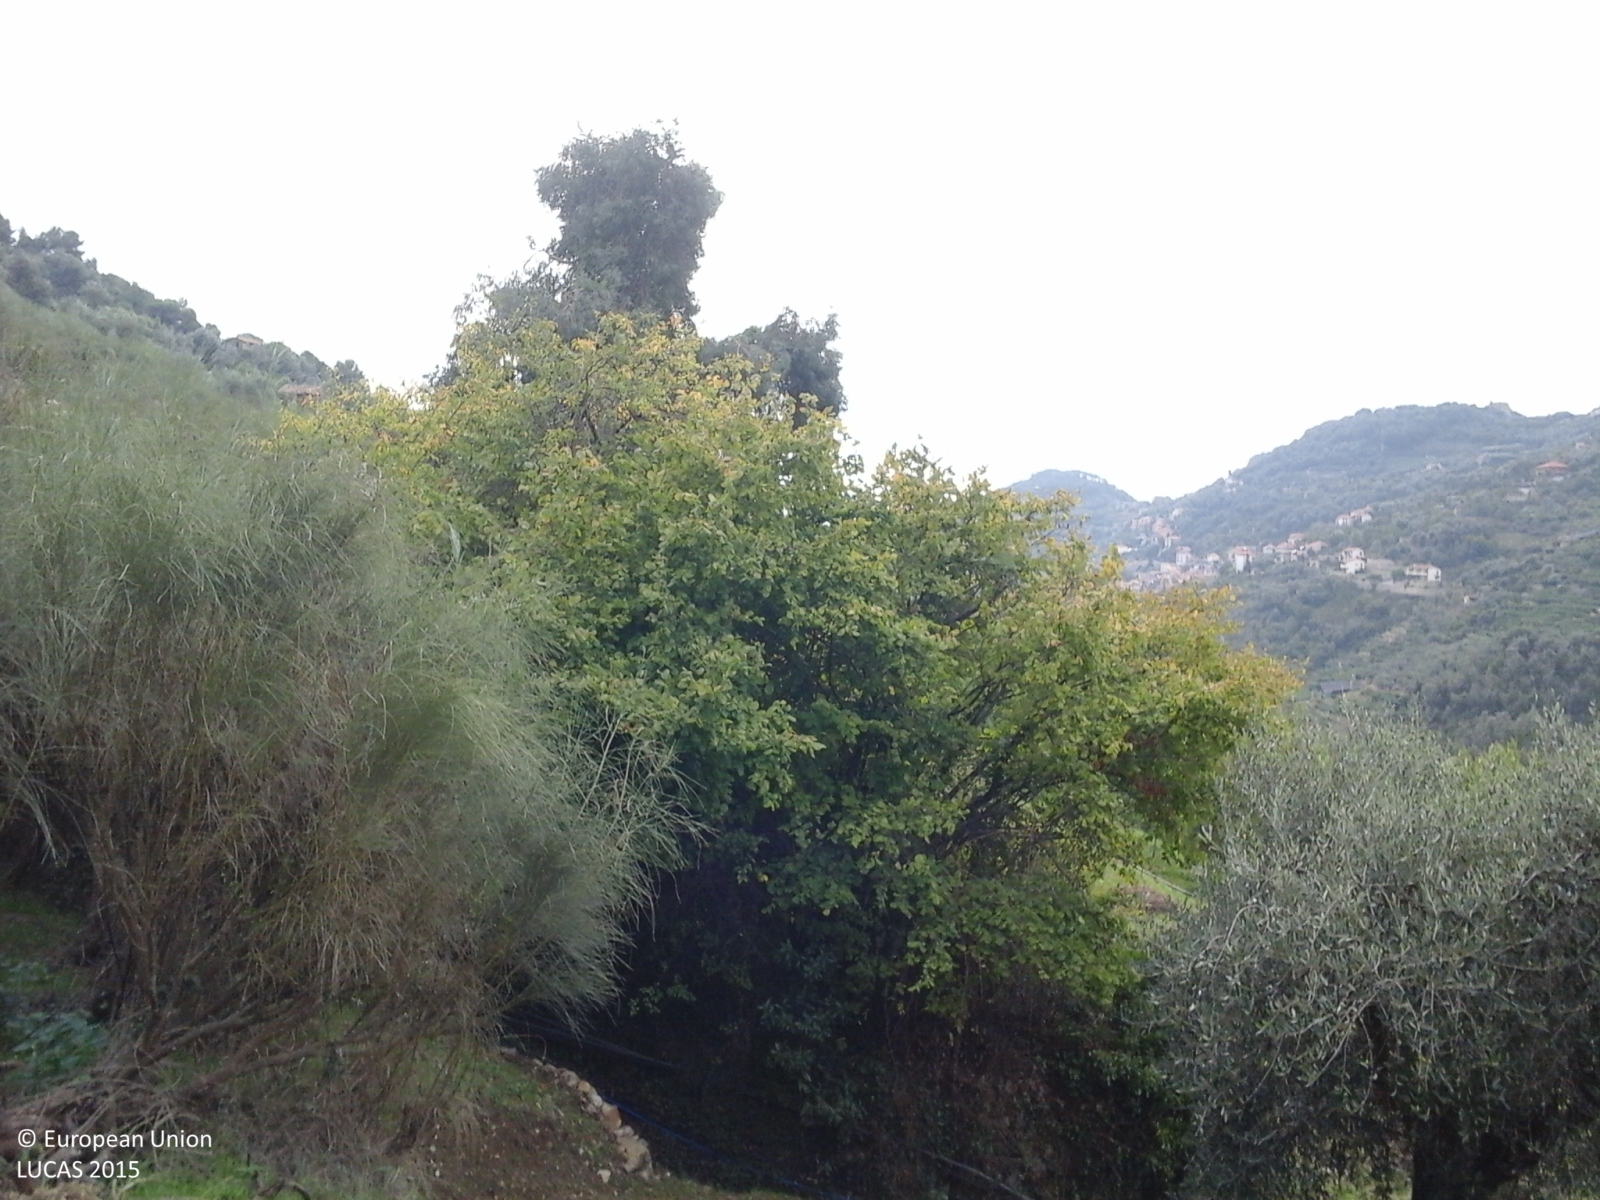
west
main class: Woodland
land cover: Broadleaved woodland
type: thermophilous deciduous forest
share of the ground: > 75 %
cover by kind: broadleaved forest trees 80 %, shrubs 15 %, herbaceous plants 5 %
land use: Semi-natural and natural areas not in use
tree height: > 5 m
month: October
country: IT
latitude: 43.8194
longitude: 7.6807
